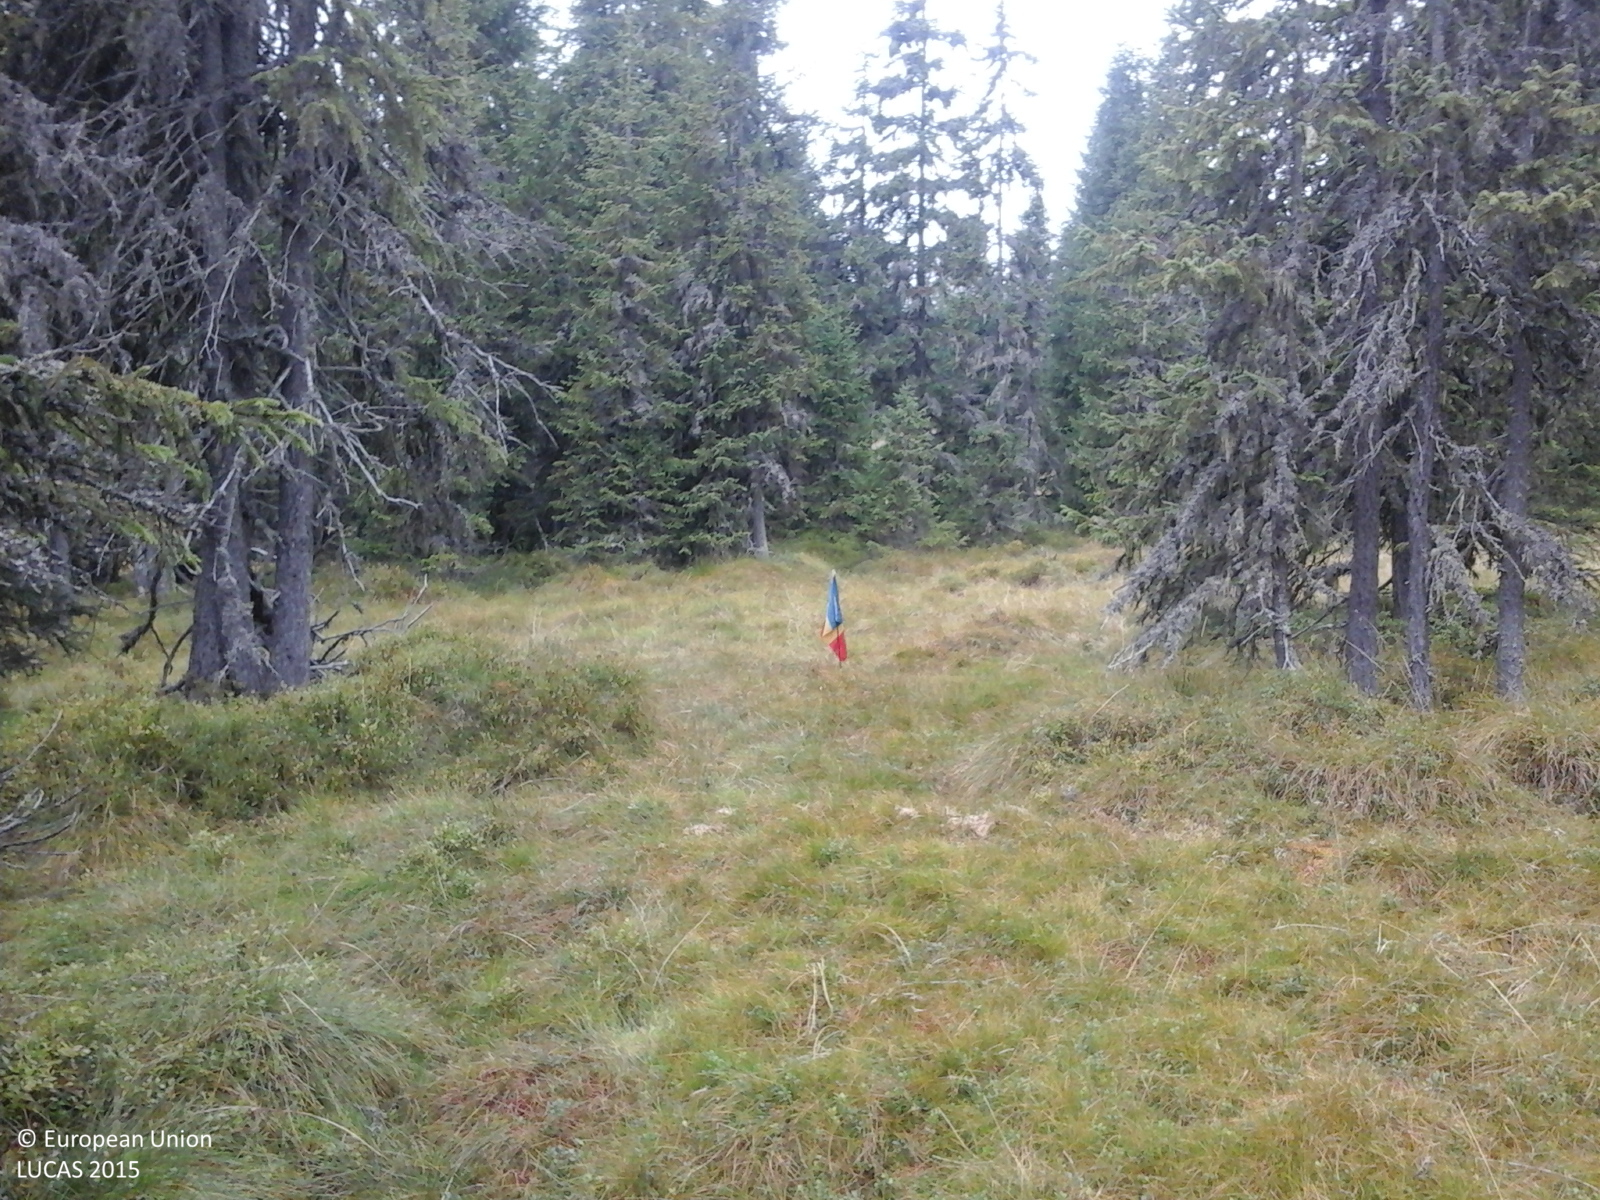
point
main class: Woodland
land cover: Spruce dominated coniferous woodland
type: alpine coniferous forest
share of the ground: > 75 %
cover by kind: coniferous forest trees 100 %
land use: Forestry
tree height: > 5 m
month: October
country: RO
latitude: 46.5185
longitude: 23.1619
